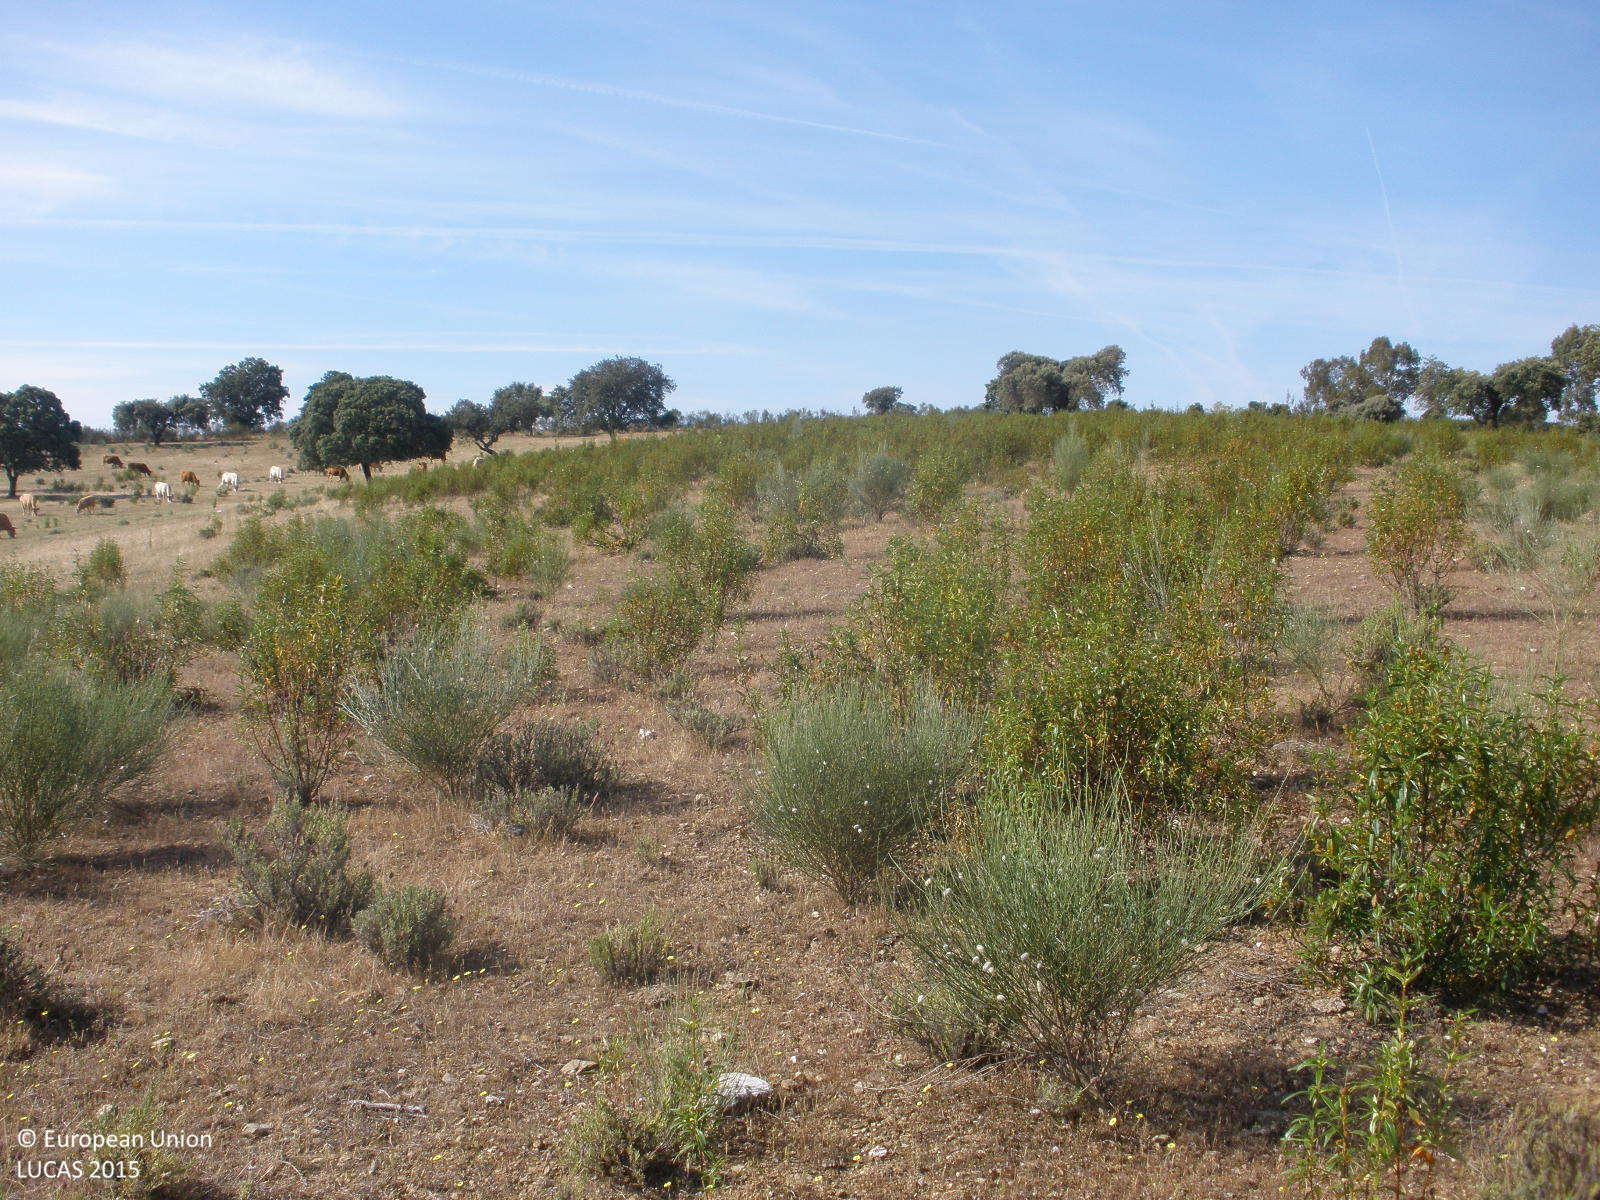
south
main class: Shrubland
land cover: Shrubland without tree cover
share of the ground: > 75 %
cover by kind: shrubs 50 %, herbaceous plants 35 %, consolidated bare surface 15 %
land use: Agriculture (excluding fallow land and kitchen gardens)
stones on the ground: 25 - 50 %
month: May
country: ES
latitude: 40.0694
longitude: -6.7474
